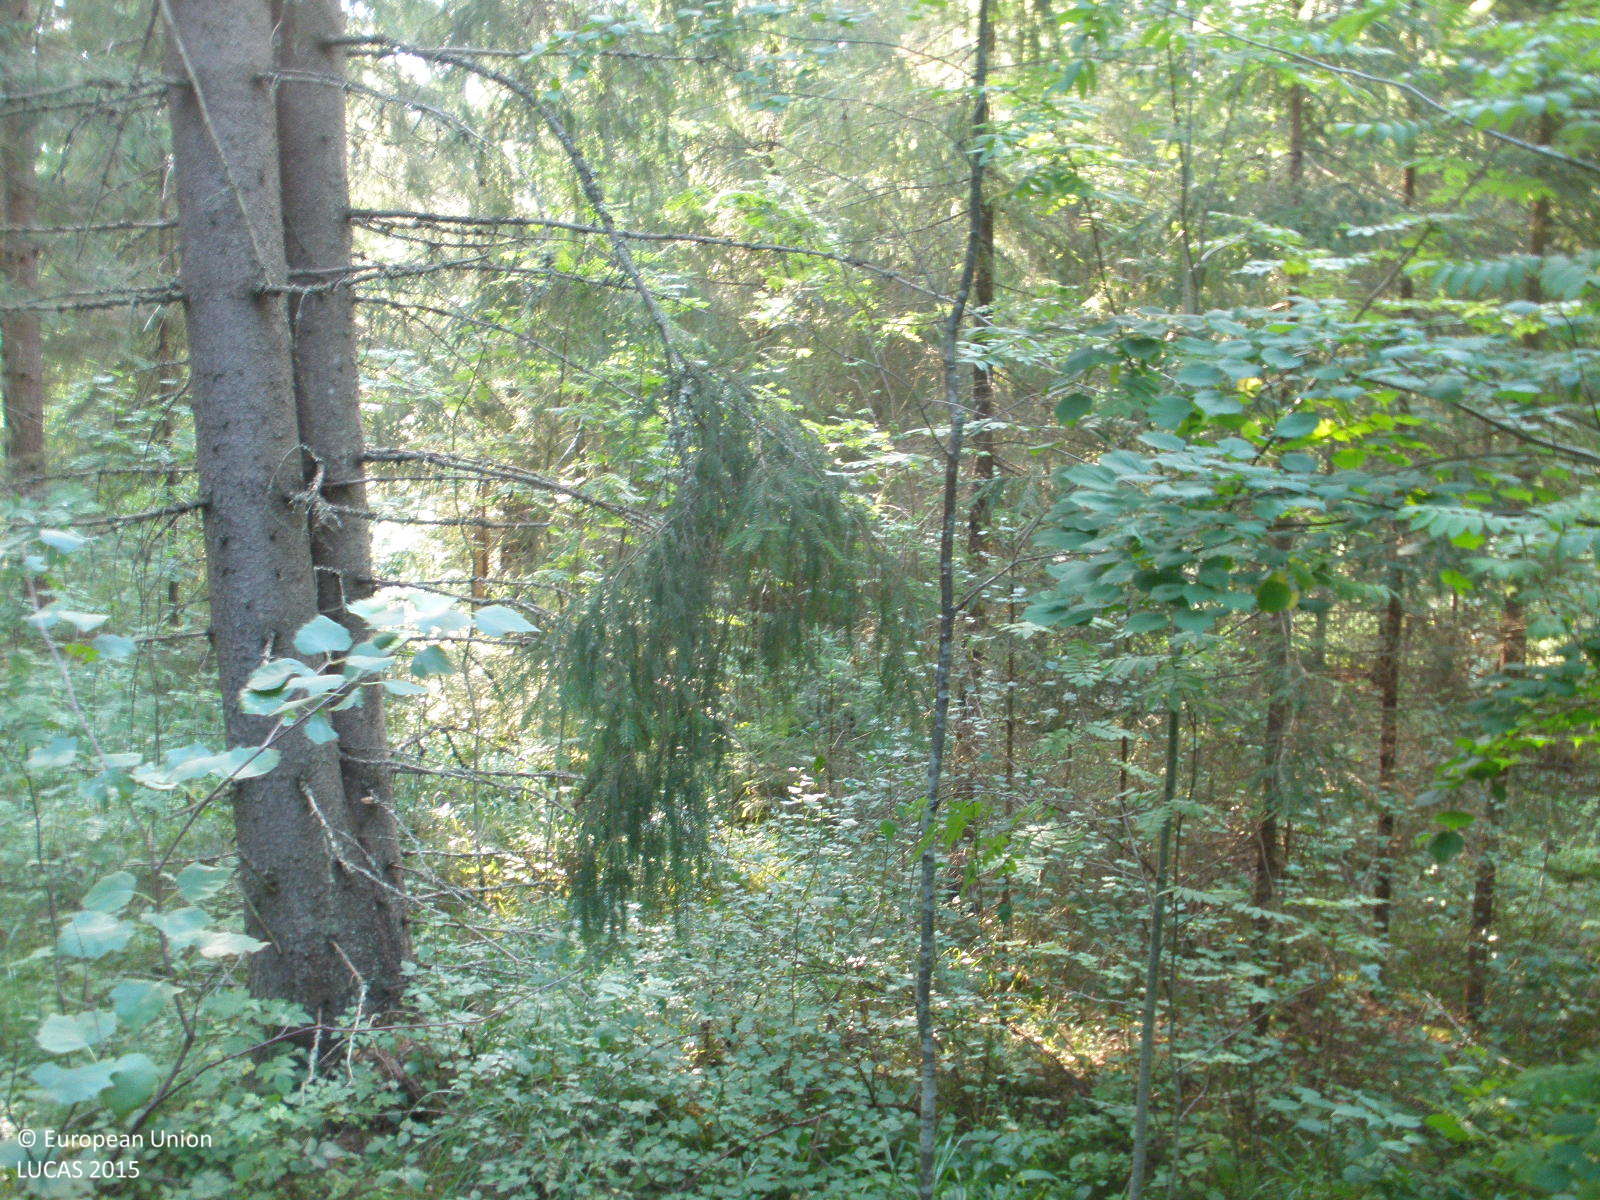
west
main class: Woodland
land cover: Spruce dominated mixed woodland
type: boreal forest
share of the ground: > 75 %
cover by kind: coniferous forest trees 65 %, broadleaved forest trees 25 %, herbaceous plants 10 %
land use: Forestry
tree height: > 5 m
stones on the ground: < 10 %
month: August
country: FI
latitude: 60.9740
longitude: 24.7974
